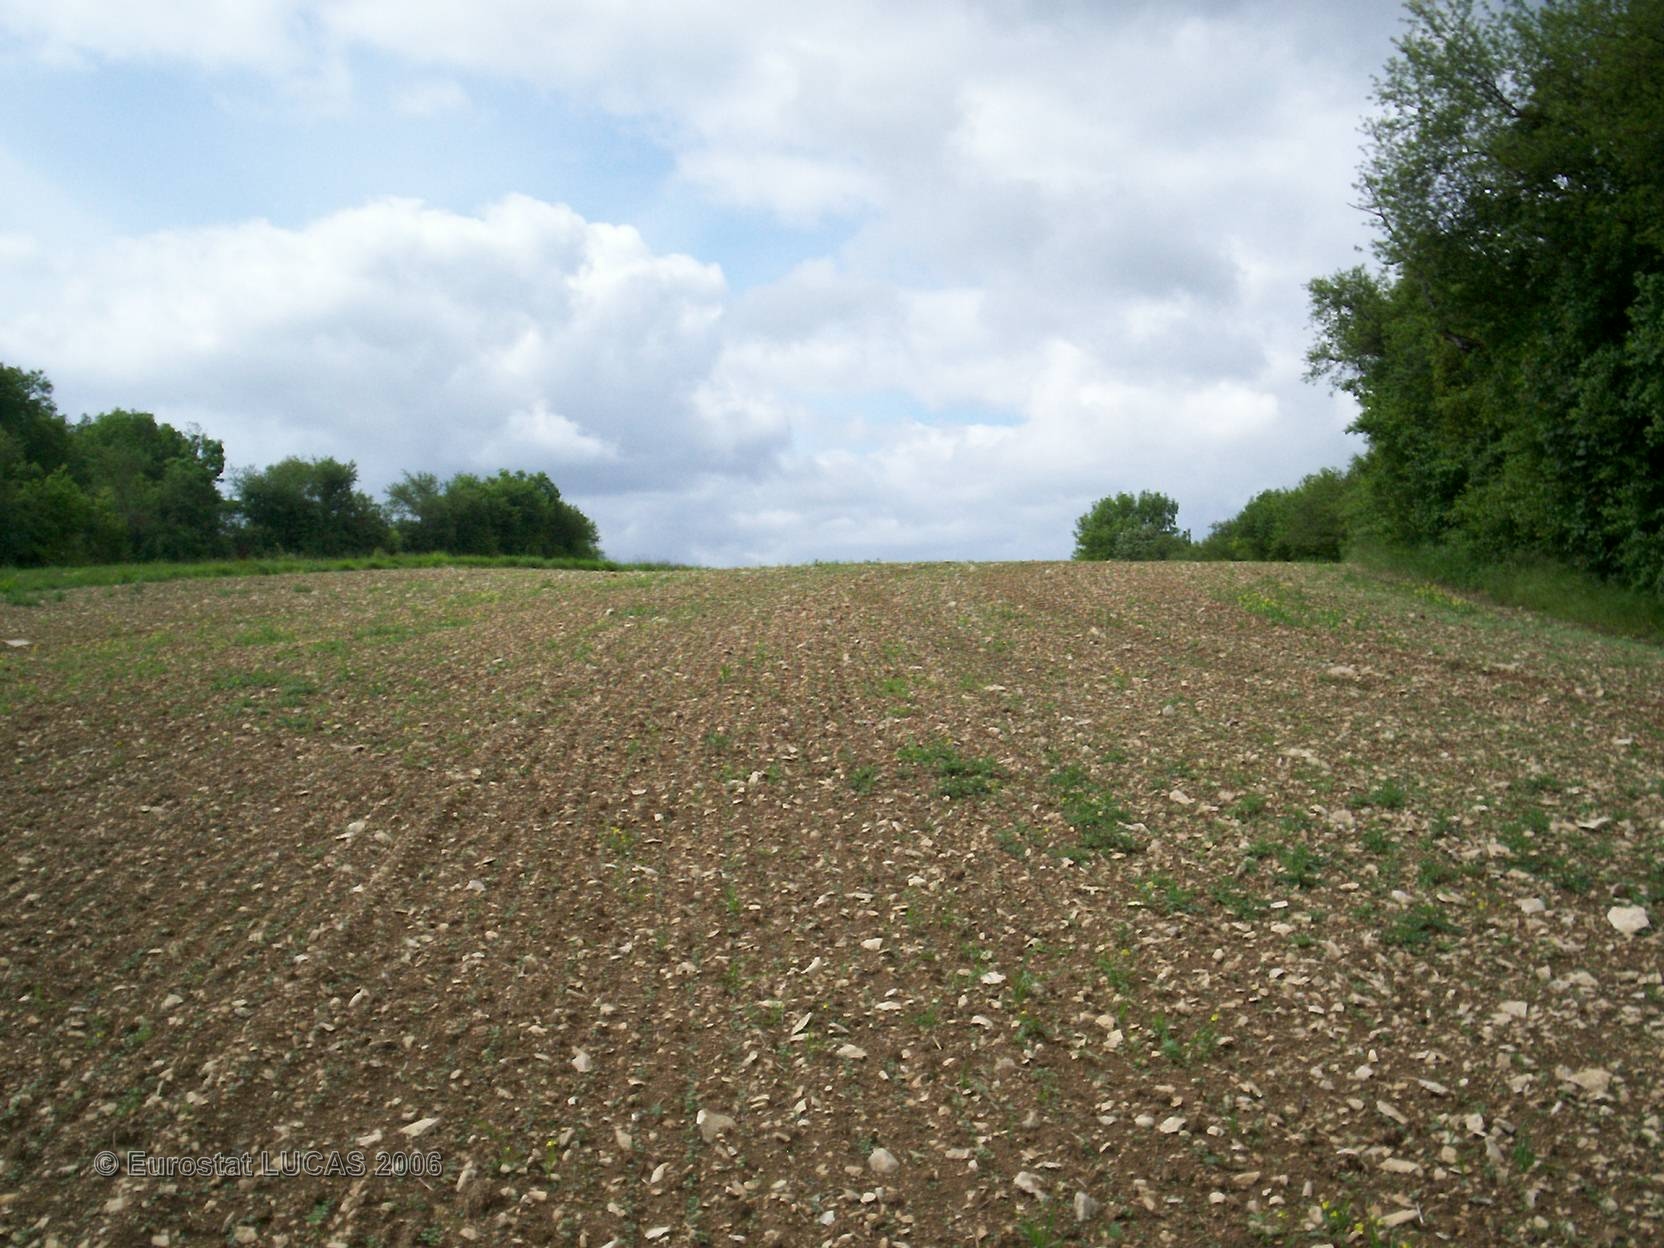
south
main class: Cropland
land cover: Clovers
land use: Fallow land
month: May
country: FR
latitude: 47.0843
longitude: 4.6657
